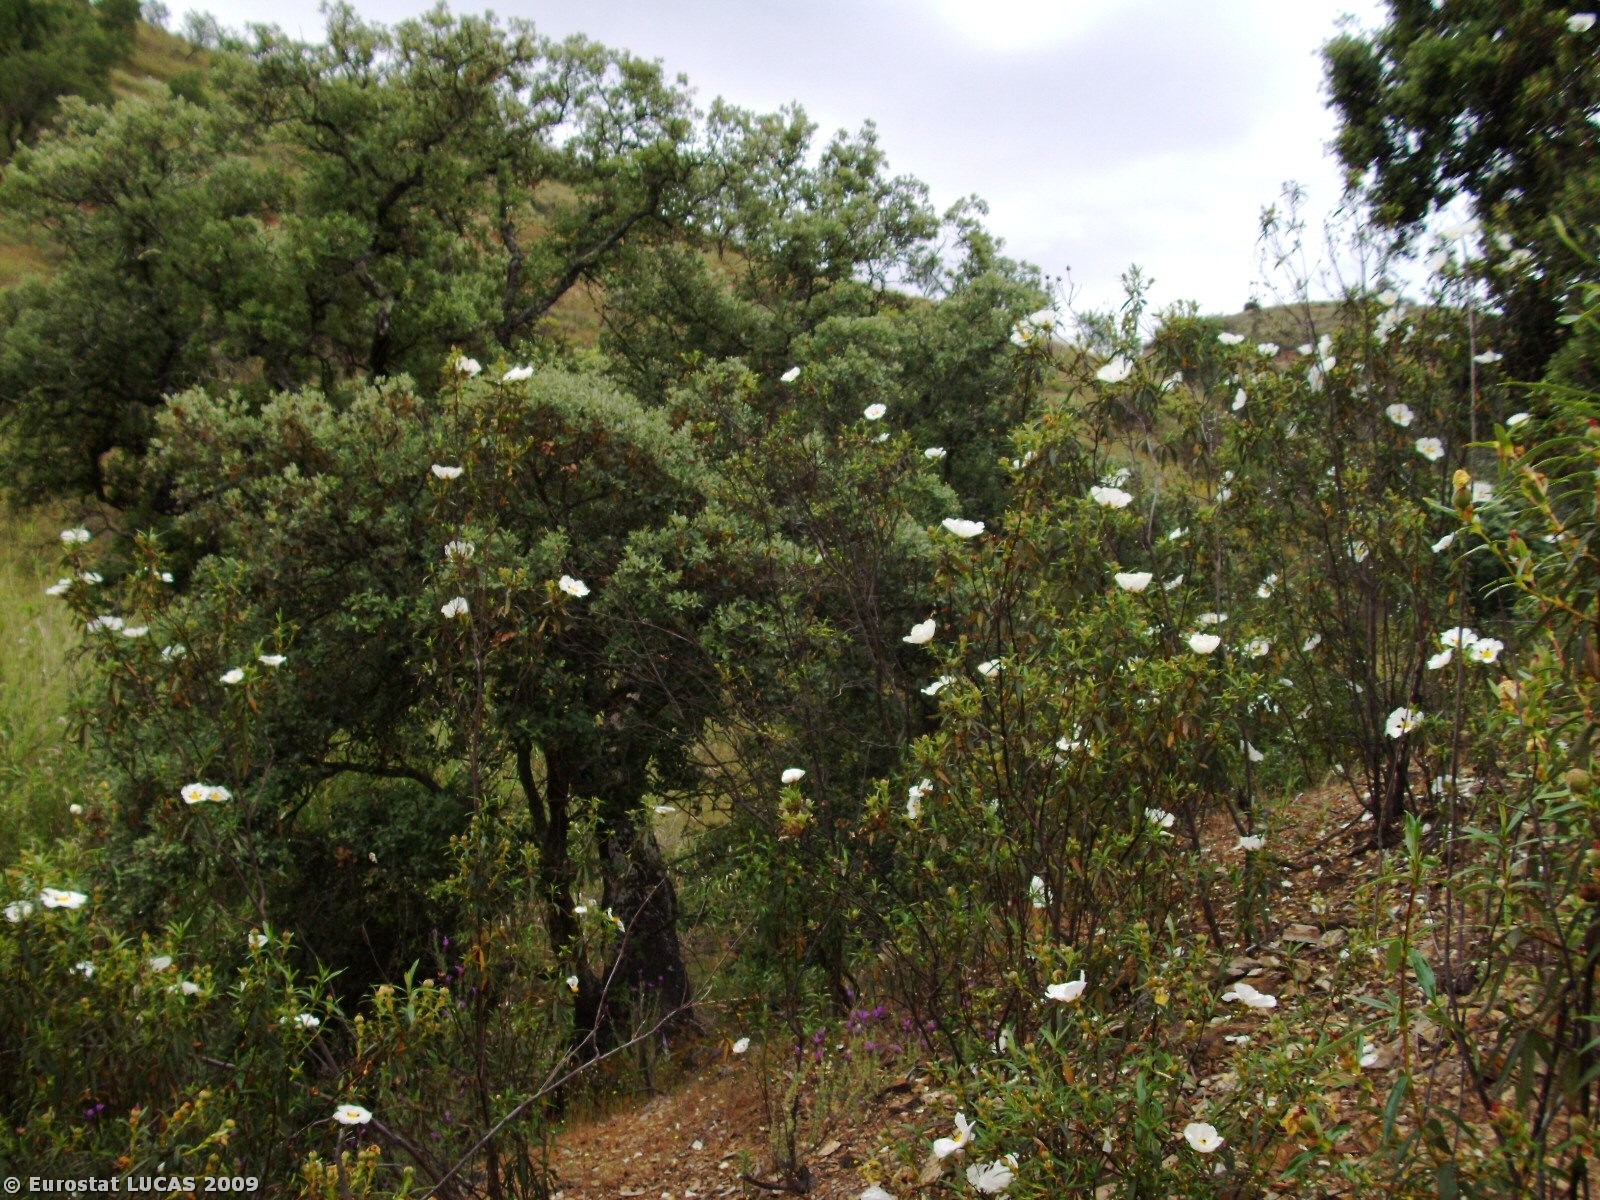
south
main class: Shrubland
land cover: Shrubland with sparse tree cover
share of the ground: 25 - 50 %
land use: Unused
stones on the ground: 25 - 50 %
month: April
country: PT
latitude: 37.2697
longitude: -7.6333
